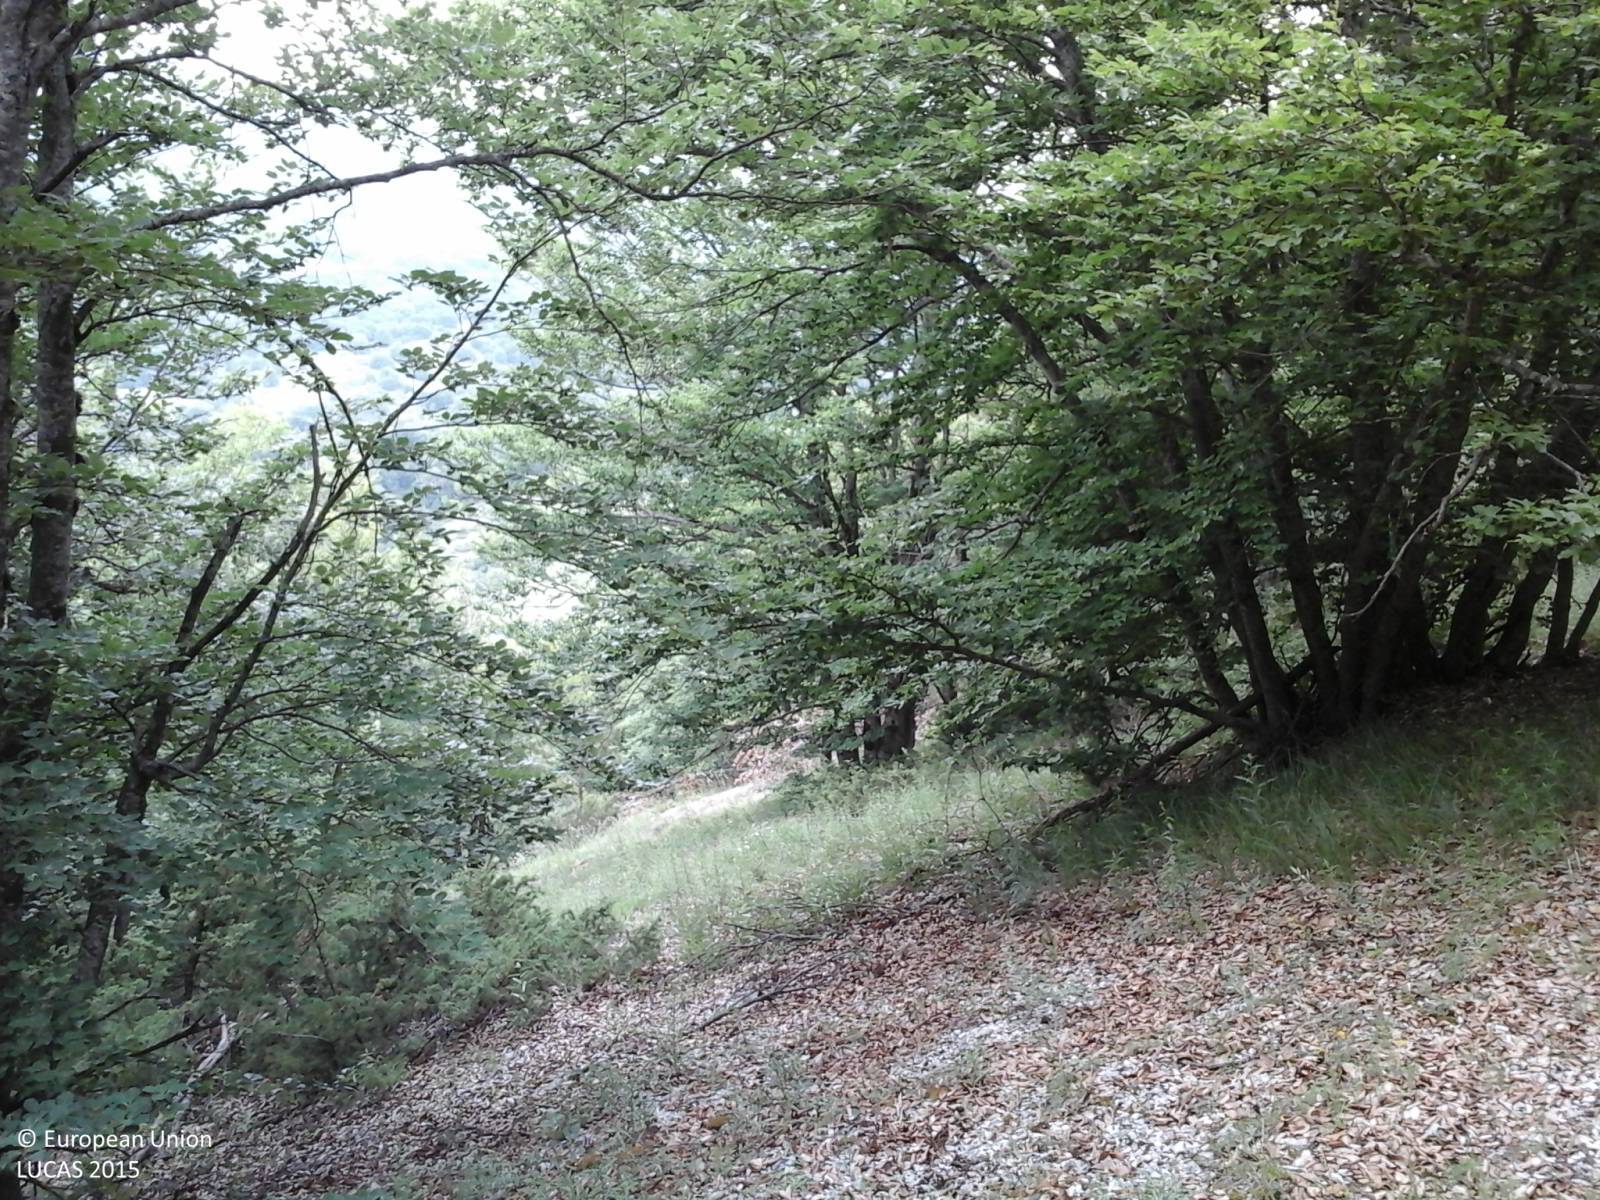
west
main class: Woodland
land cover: Broadleaved woodland
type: mountainous beech forest
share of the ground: > 75 %
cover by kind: broadleaved forest trees 85 %, shrubs 10 %, herbaceous plants 5 %
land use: Forestry
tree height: > 5 m
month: June
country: IT
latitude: 41.9941
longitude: 14.0547
